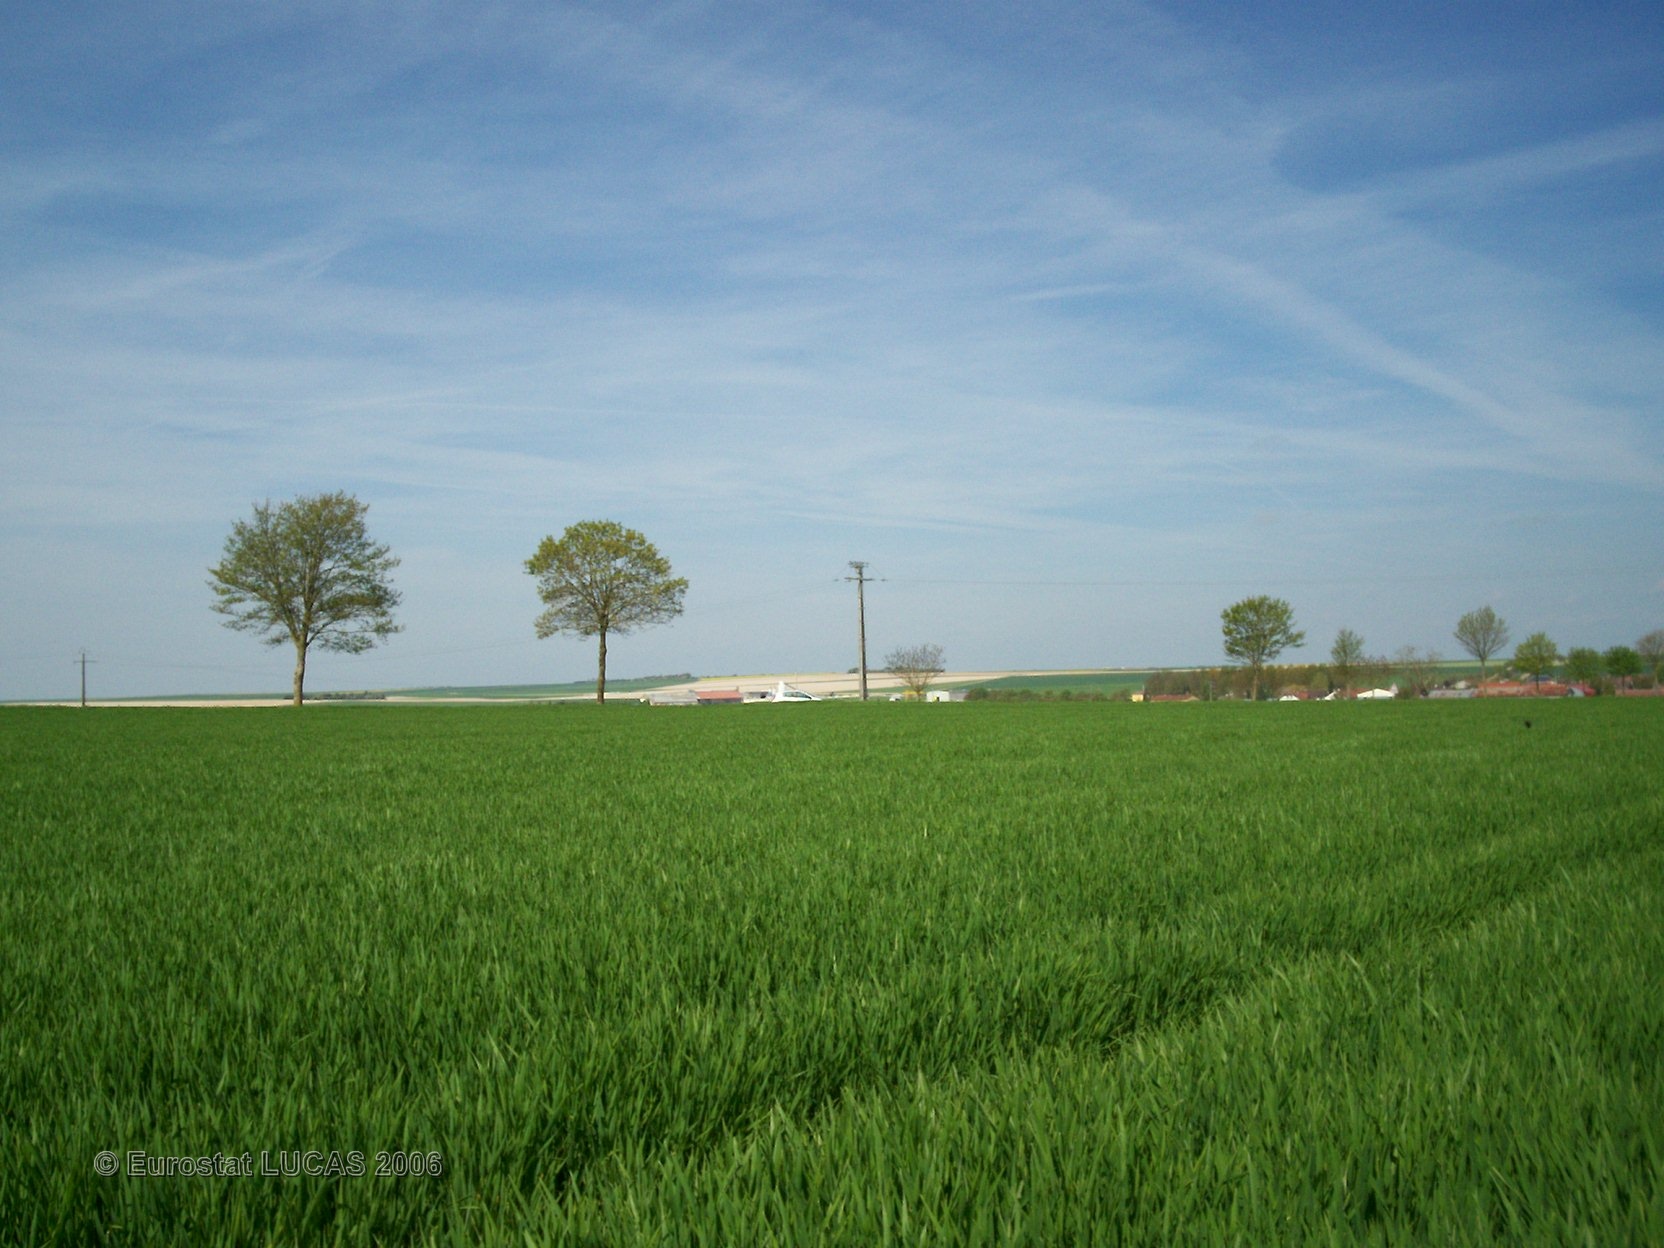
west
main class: Cropland
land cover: Barley
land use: Agriculture (excluding fallow land and kitchen gardens)
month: May
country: FR
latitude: 48.8758
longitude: 4.4199
